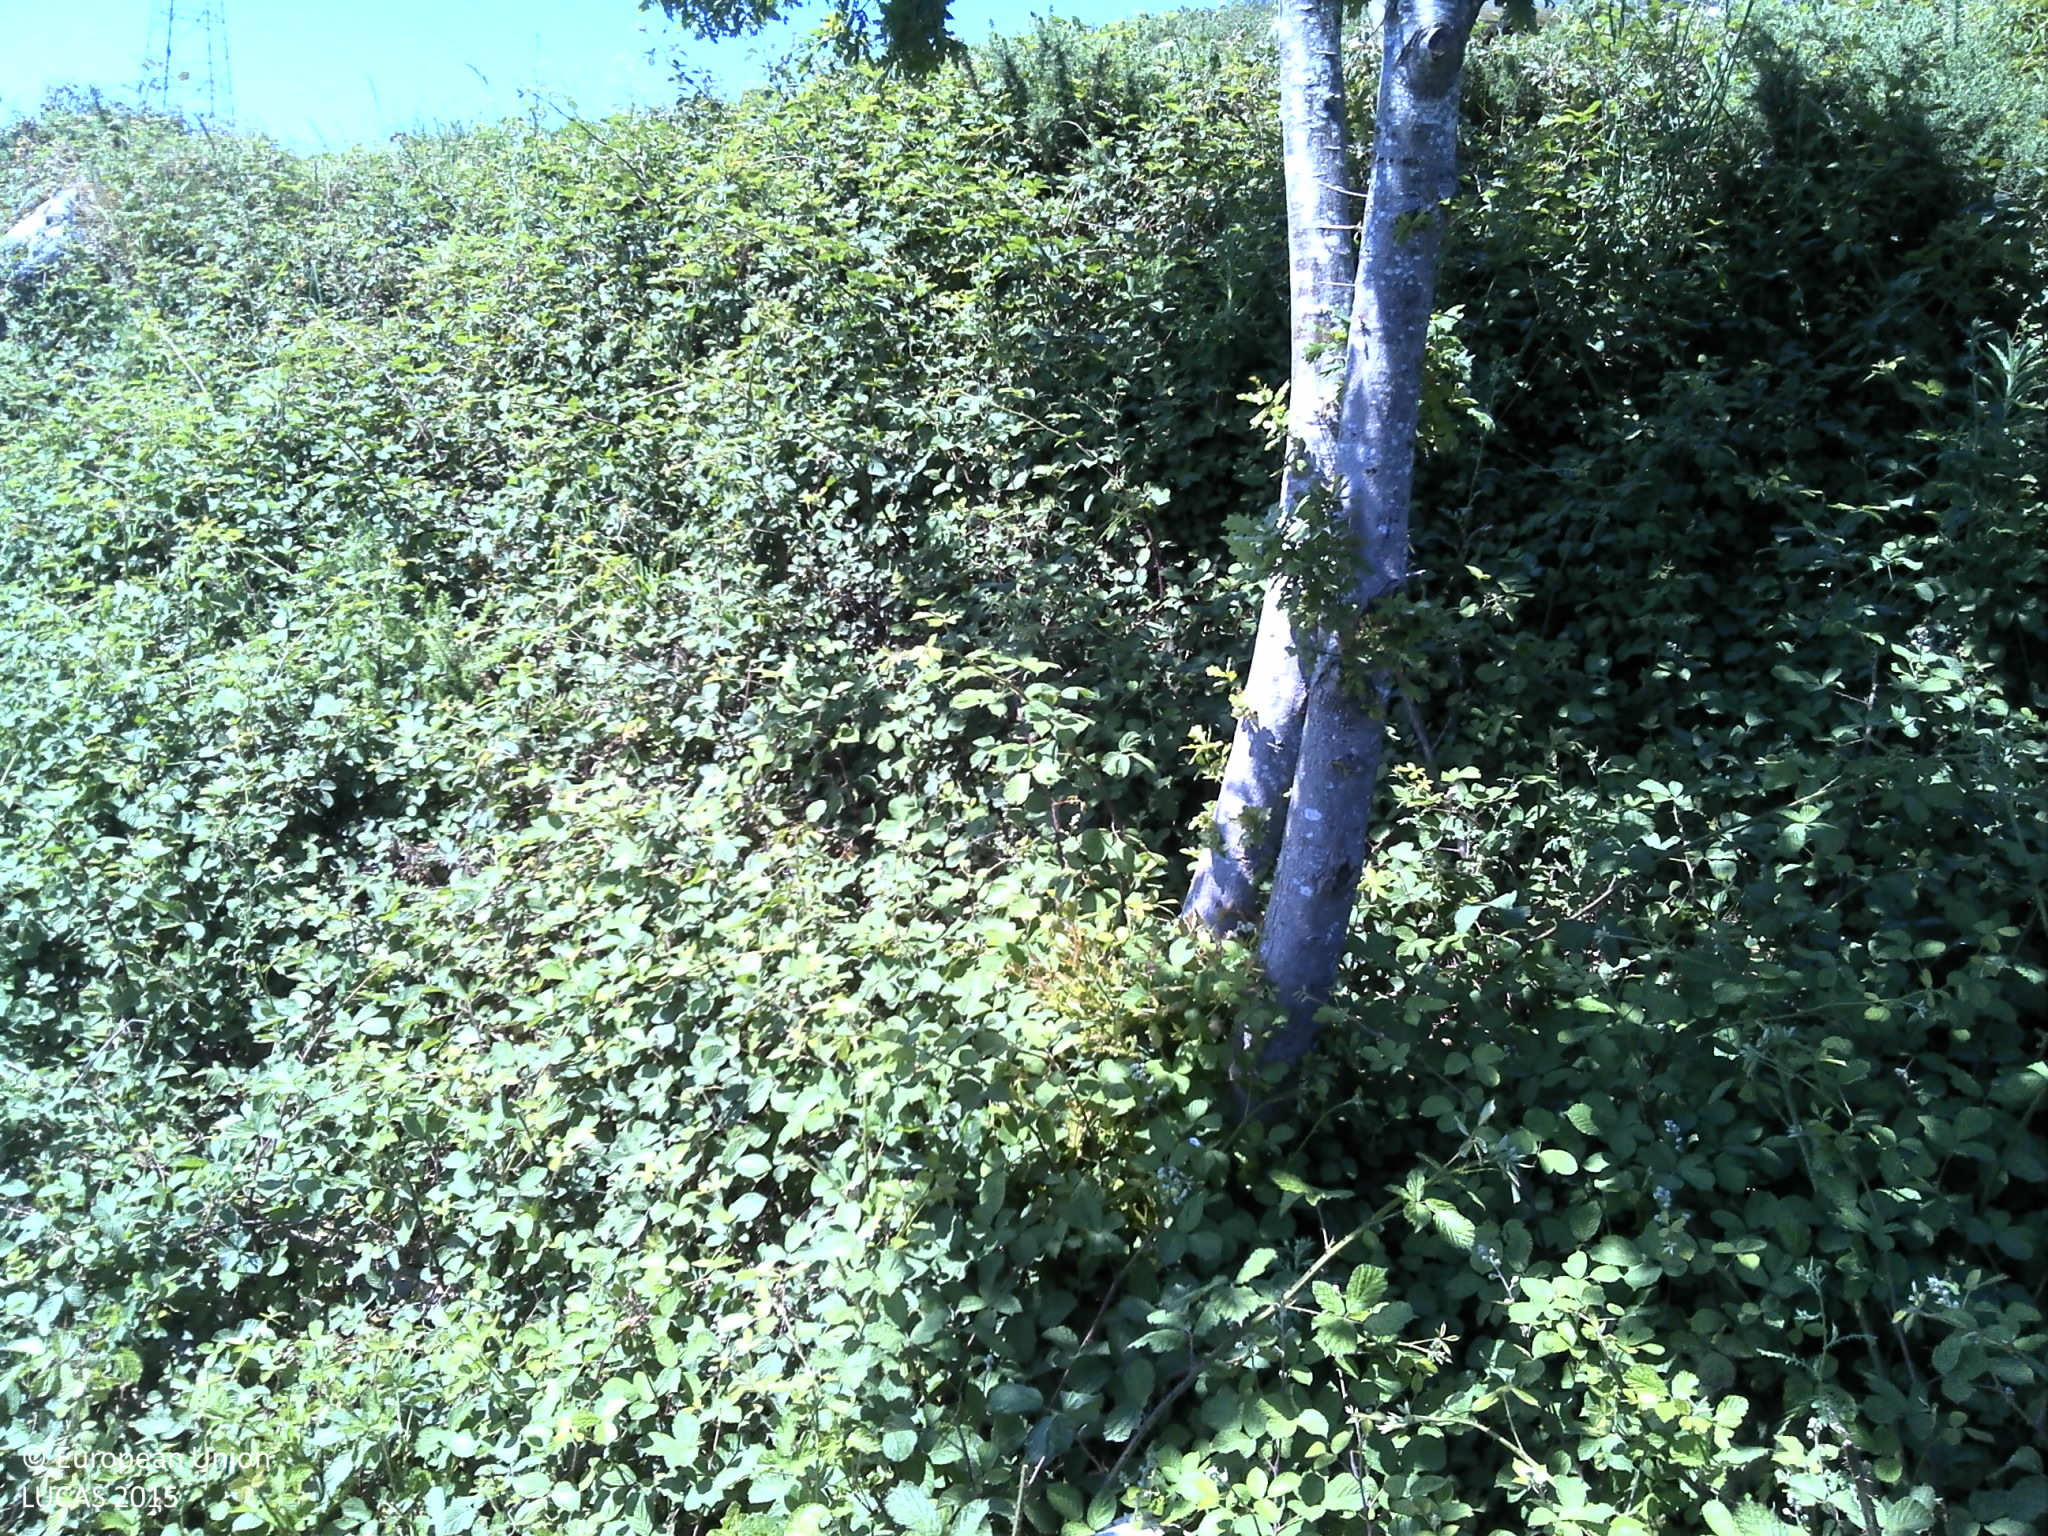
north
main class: Shrubland
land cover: Shrubland without tree cover
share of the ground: > 75 %
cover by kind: shrubs 80 %, herbaceous plants 10 %, unconsolidated bare surface 10 %
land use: Semi-natural and natural areas not in use
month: June
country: PT
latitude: 41.9991
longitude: -8.4270
